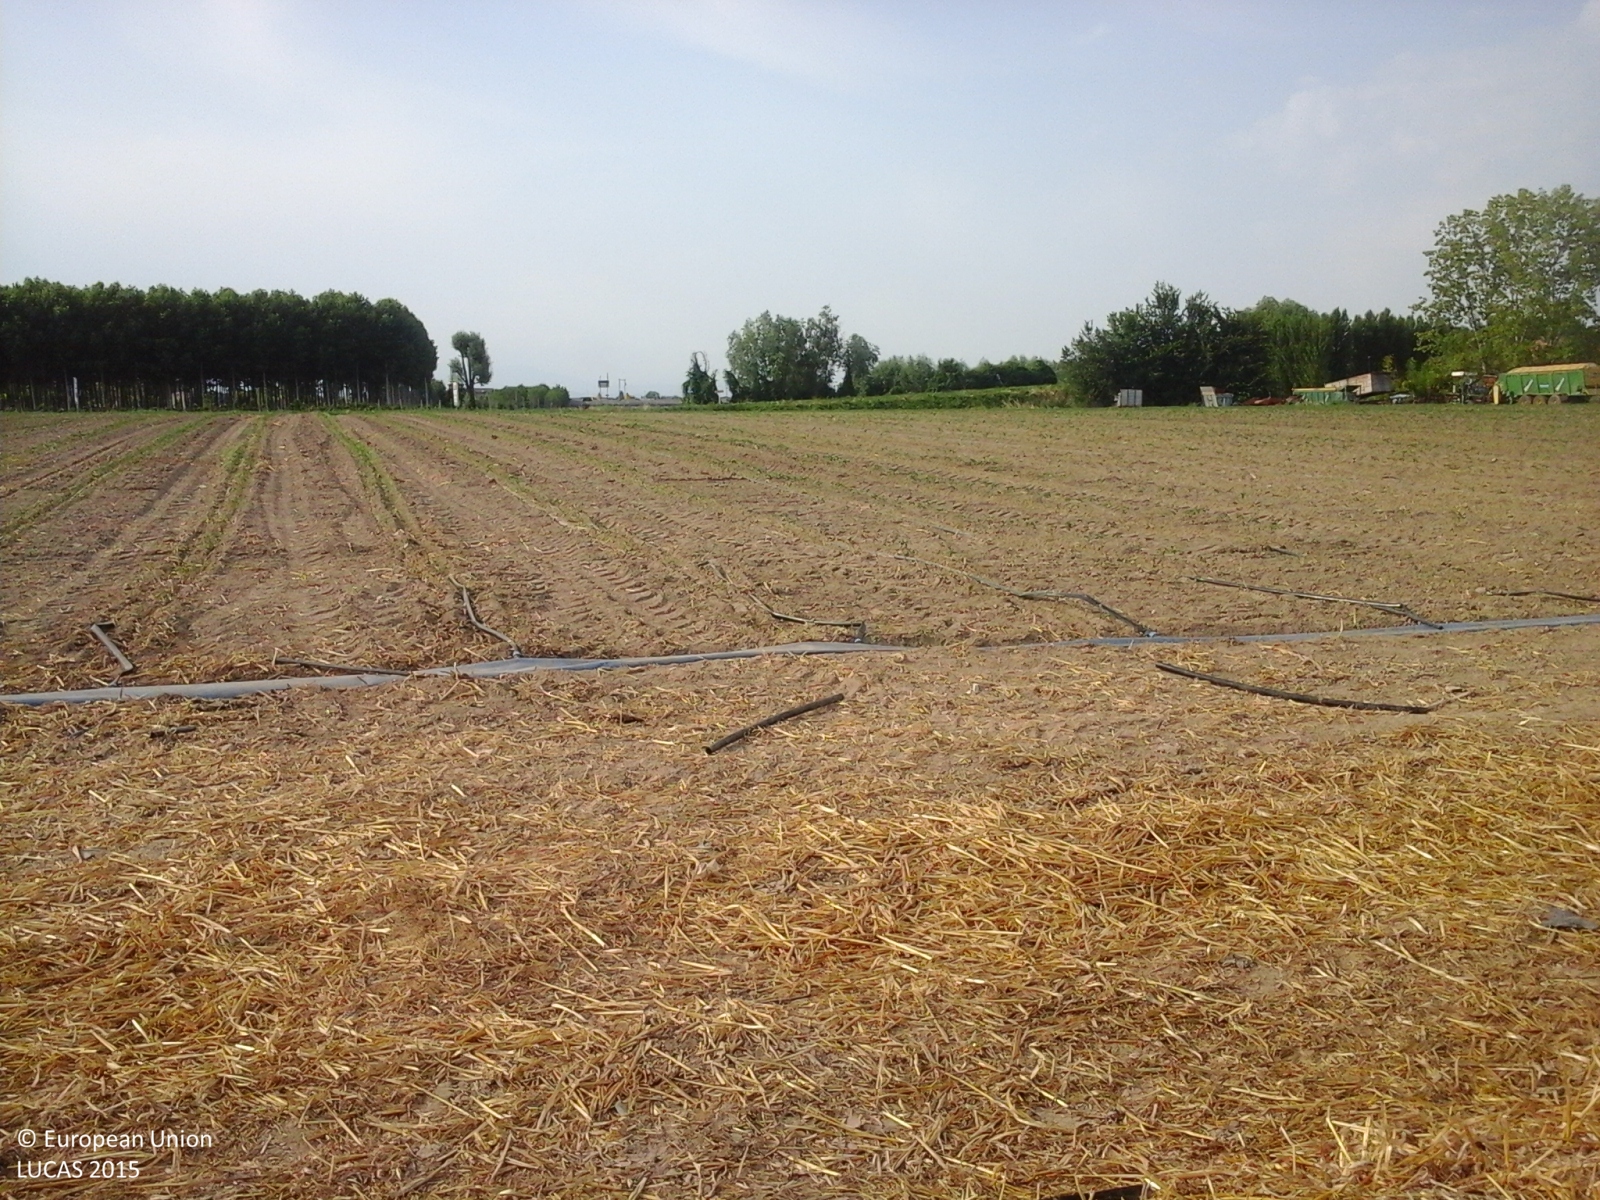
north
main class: Cropland
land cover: Tomatoes
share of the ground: > 75 %
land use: Agriculture (excluding fallow land and kitchen gardens)
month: June
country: IT
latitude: 45.2268
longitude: 11.2332
